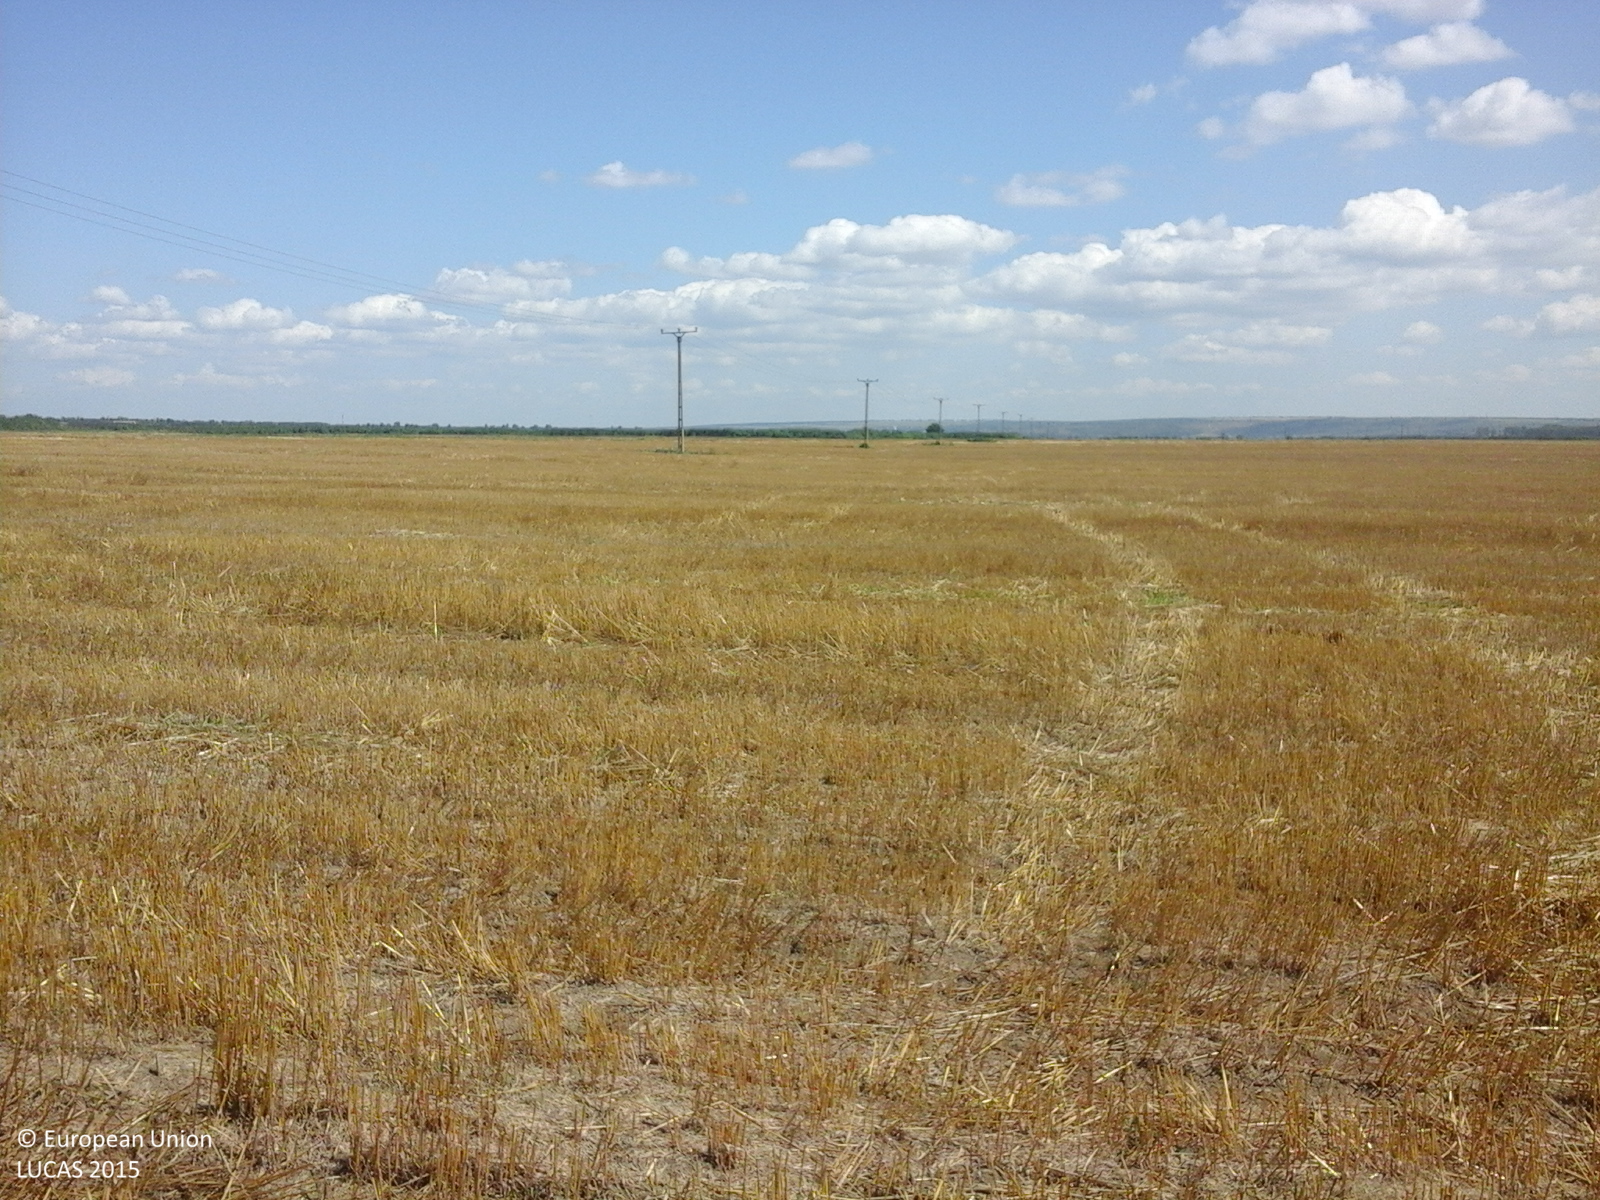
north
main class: Cropland
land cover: Common wheat
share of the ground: 50 - 75 %
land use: Agriculture (excluding fallow land and kitchen gardens)
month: July
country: RO
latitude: 46.3964
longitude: 28.1968
